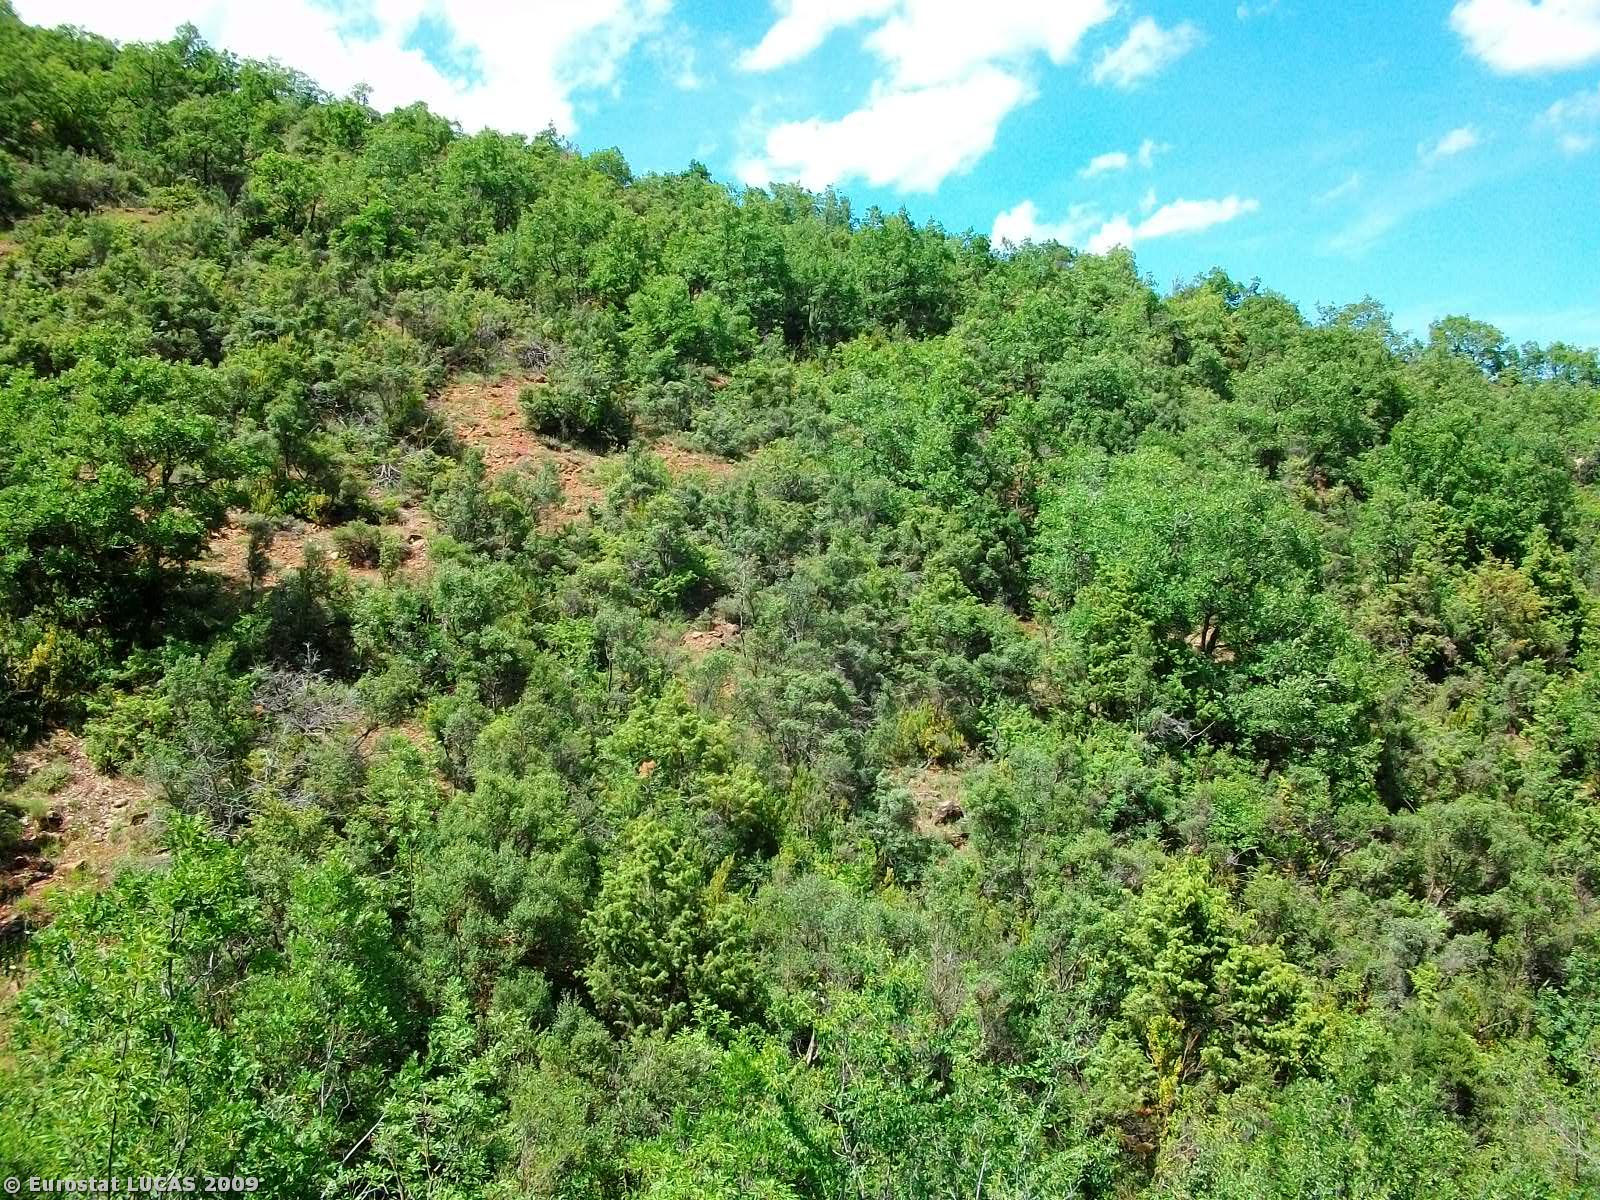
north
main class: Woodland
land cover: Broadleaved woodland
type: thermophilous deciduous forest
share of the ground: > 75 %
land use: Forestry
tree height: > 5 m
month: June
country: GR
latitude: 40.0495
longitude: 21.7693
